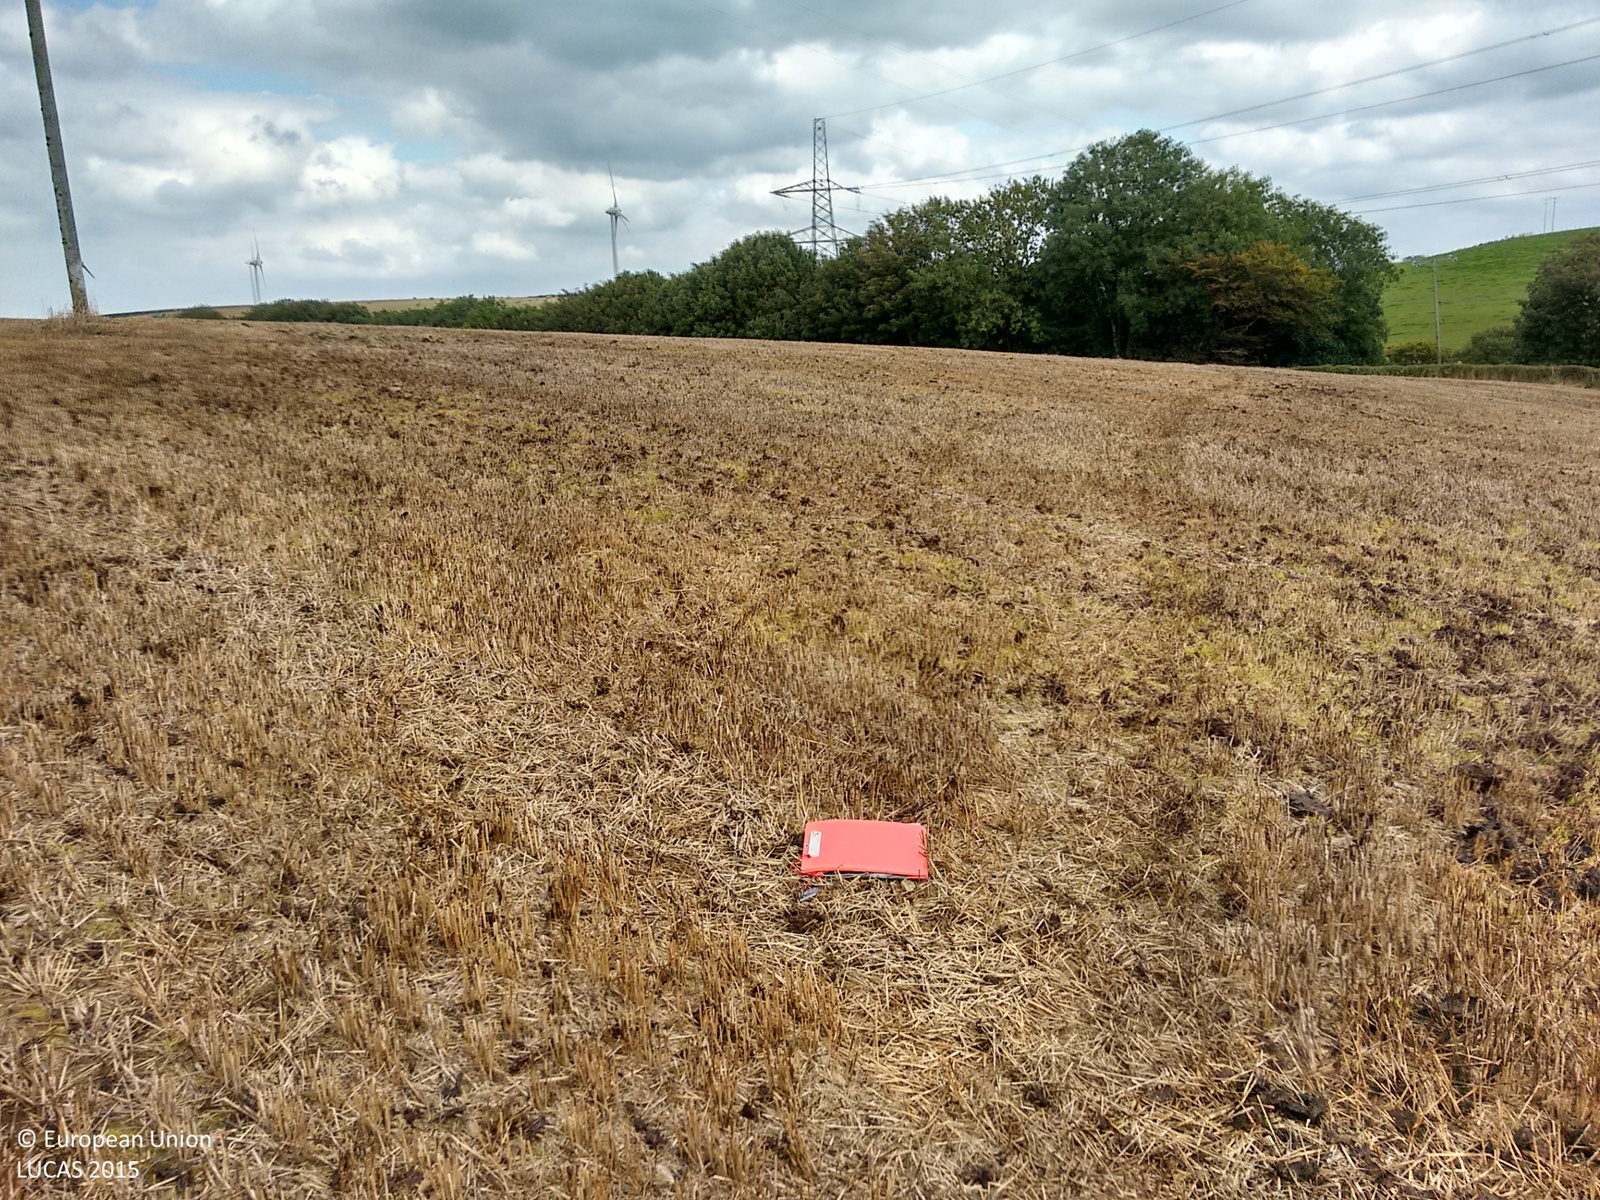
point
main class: Cropland
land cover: Barley
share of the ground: 50 - 75 %
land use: Agriculture (excluding fallow land and kitchen gardens)
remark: Harvested field
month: September
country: GB
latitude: 50.9054
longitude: -4.2781
